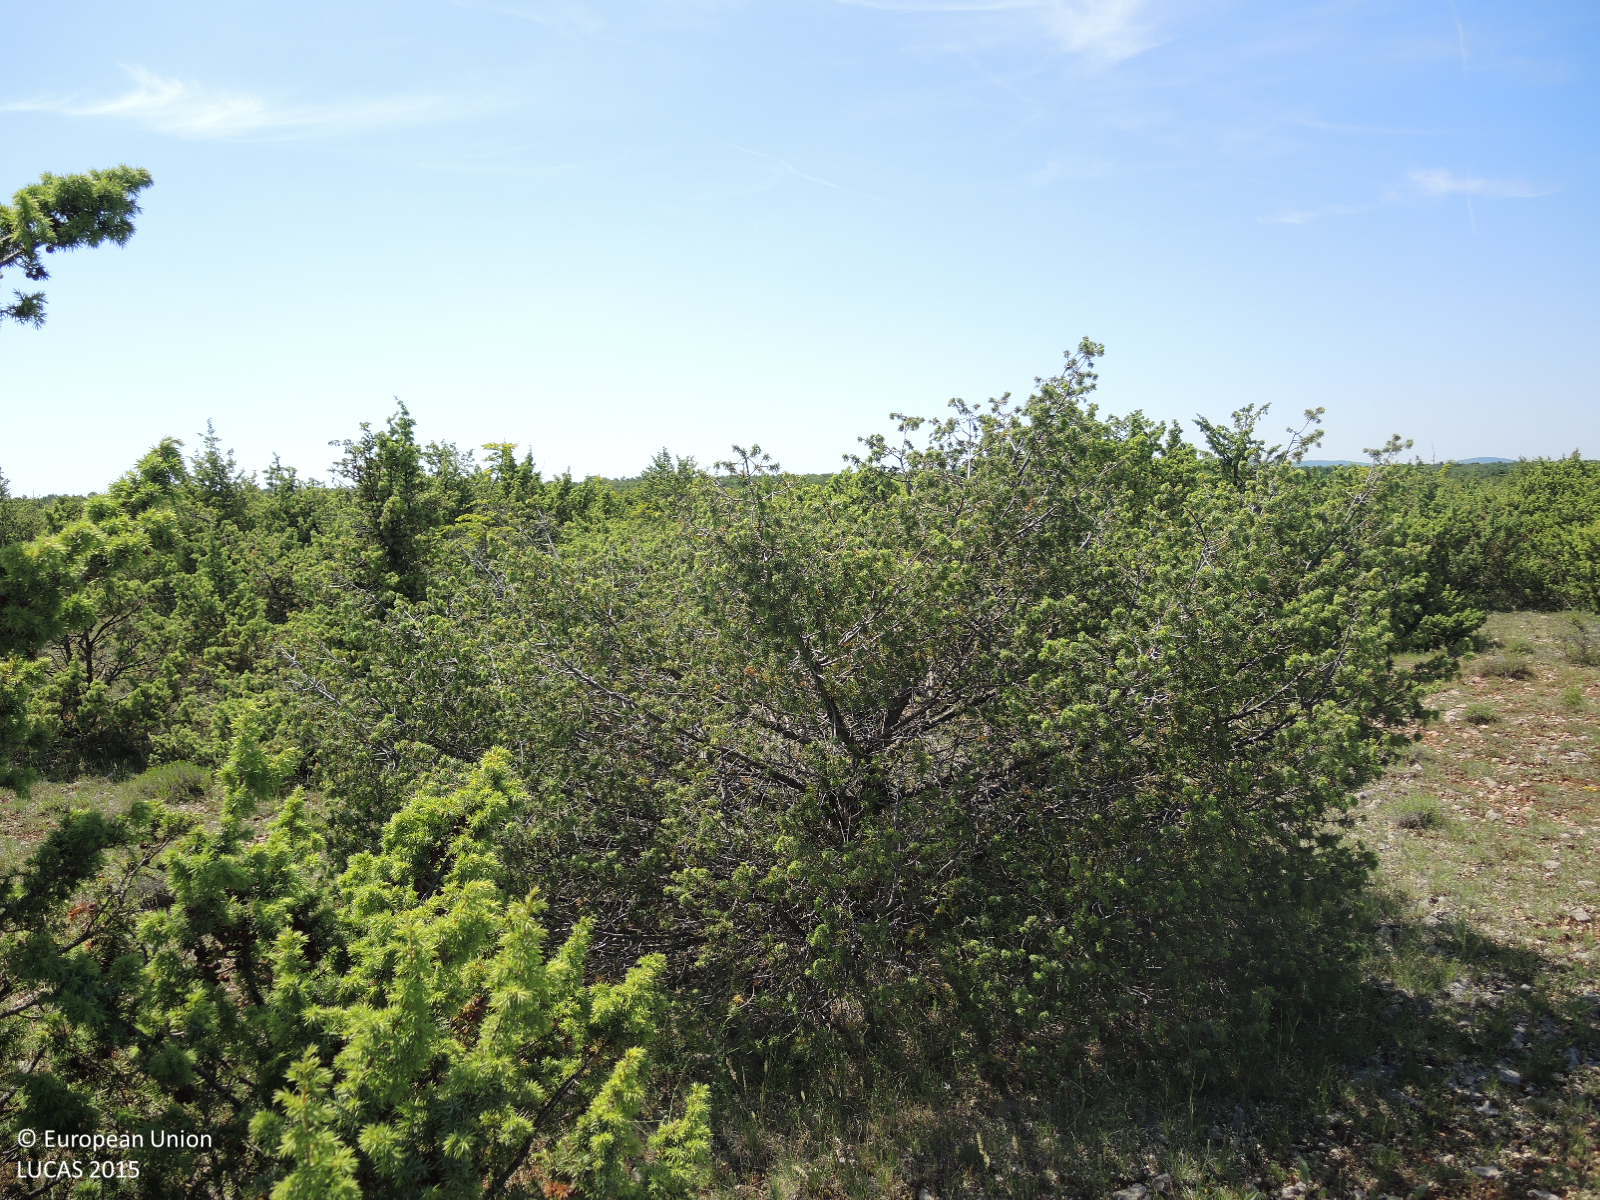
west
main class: Shrubland
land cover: Shrubland with sparse tree cover
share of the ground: 25 - 50 %
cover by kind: shrubs 45 %, herbaceous plants 45 %, coniferous forest trees 5 %, consolidated bare surface 5 %
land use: Semi-natural and natural areas not in use
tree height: < 5 m
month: May
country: HR
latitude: 43.9276
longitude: 15.9332
